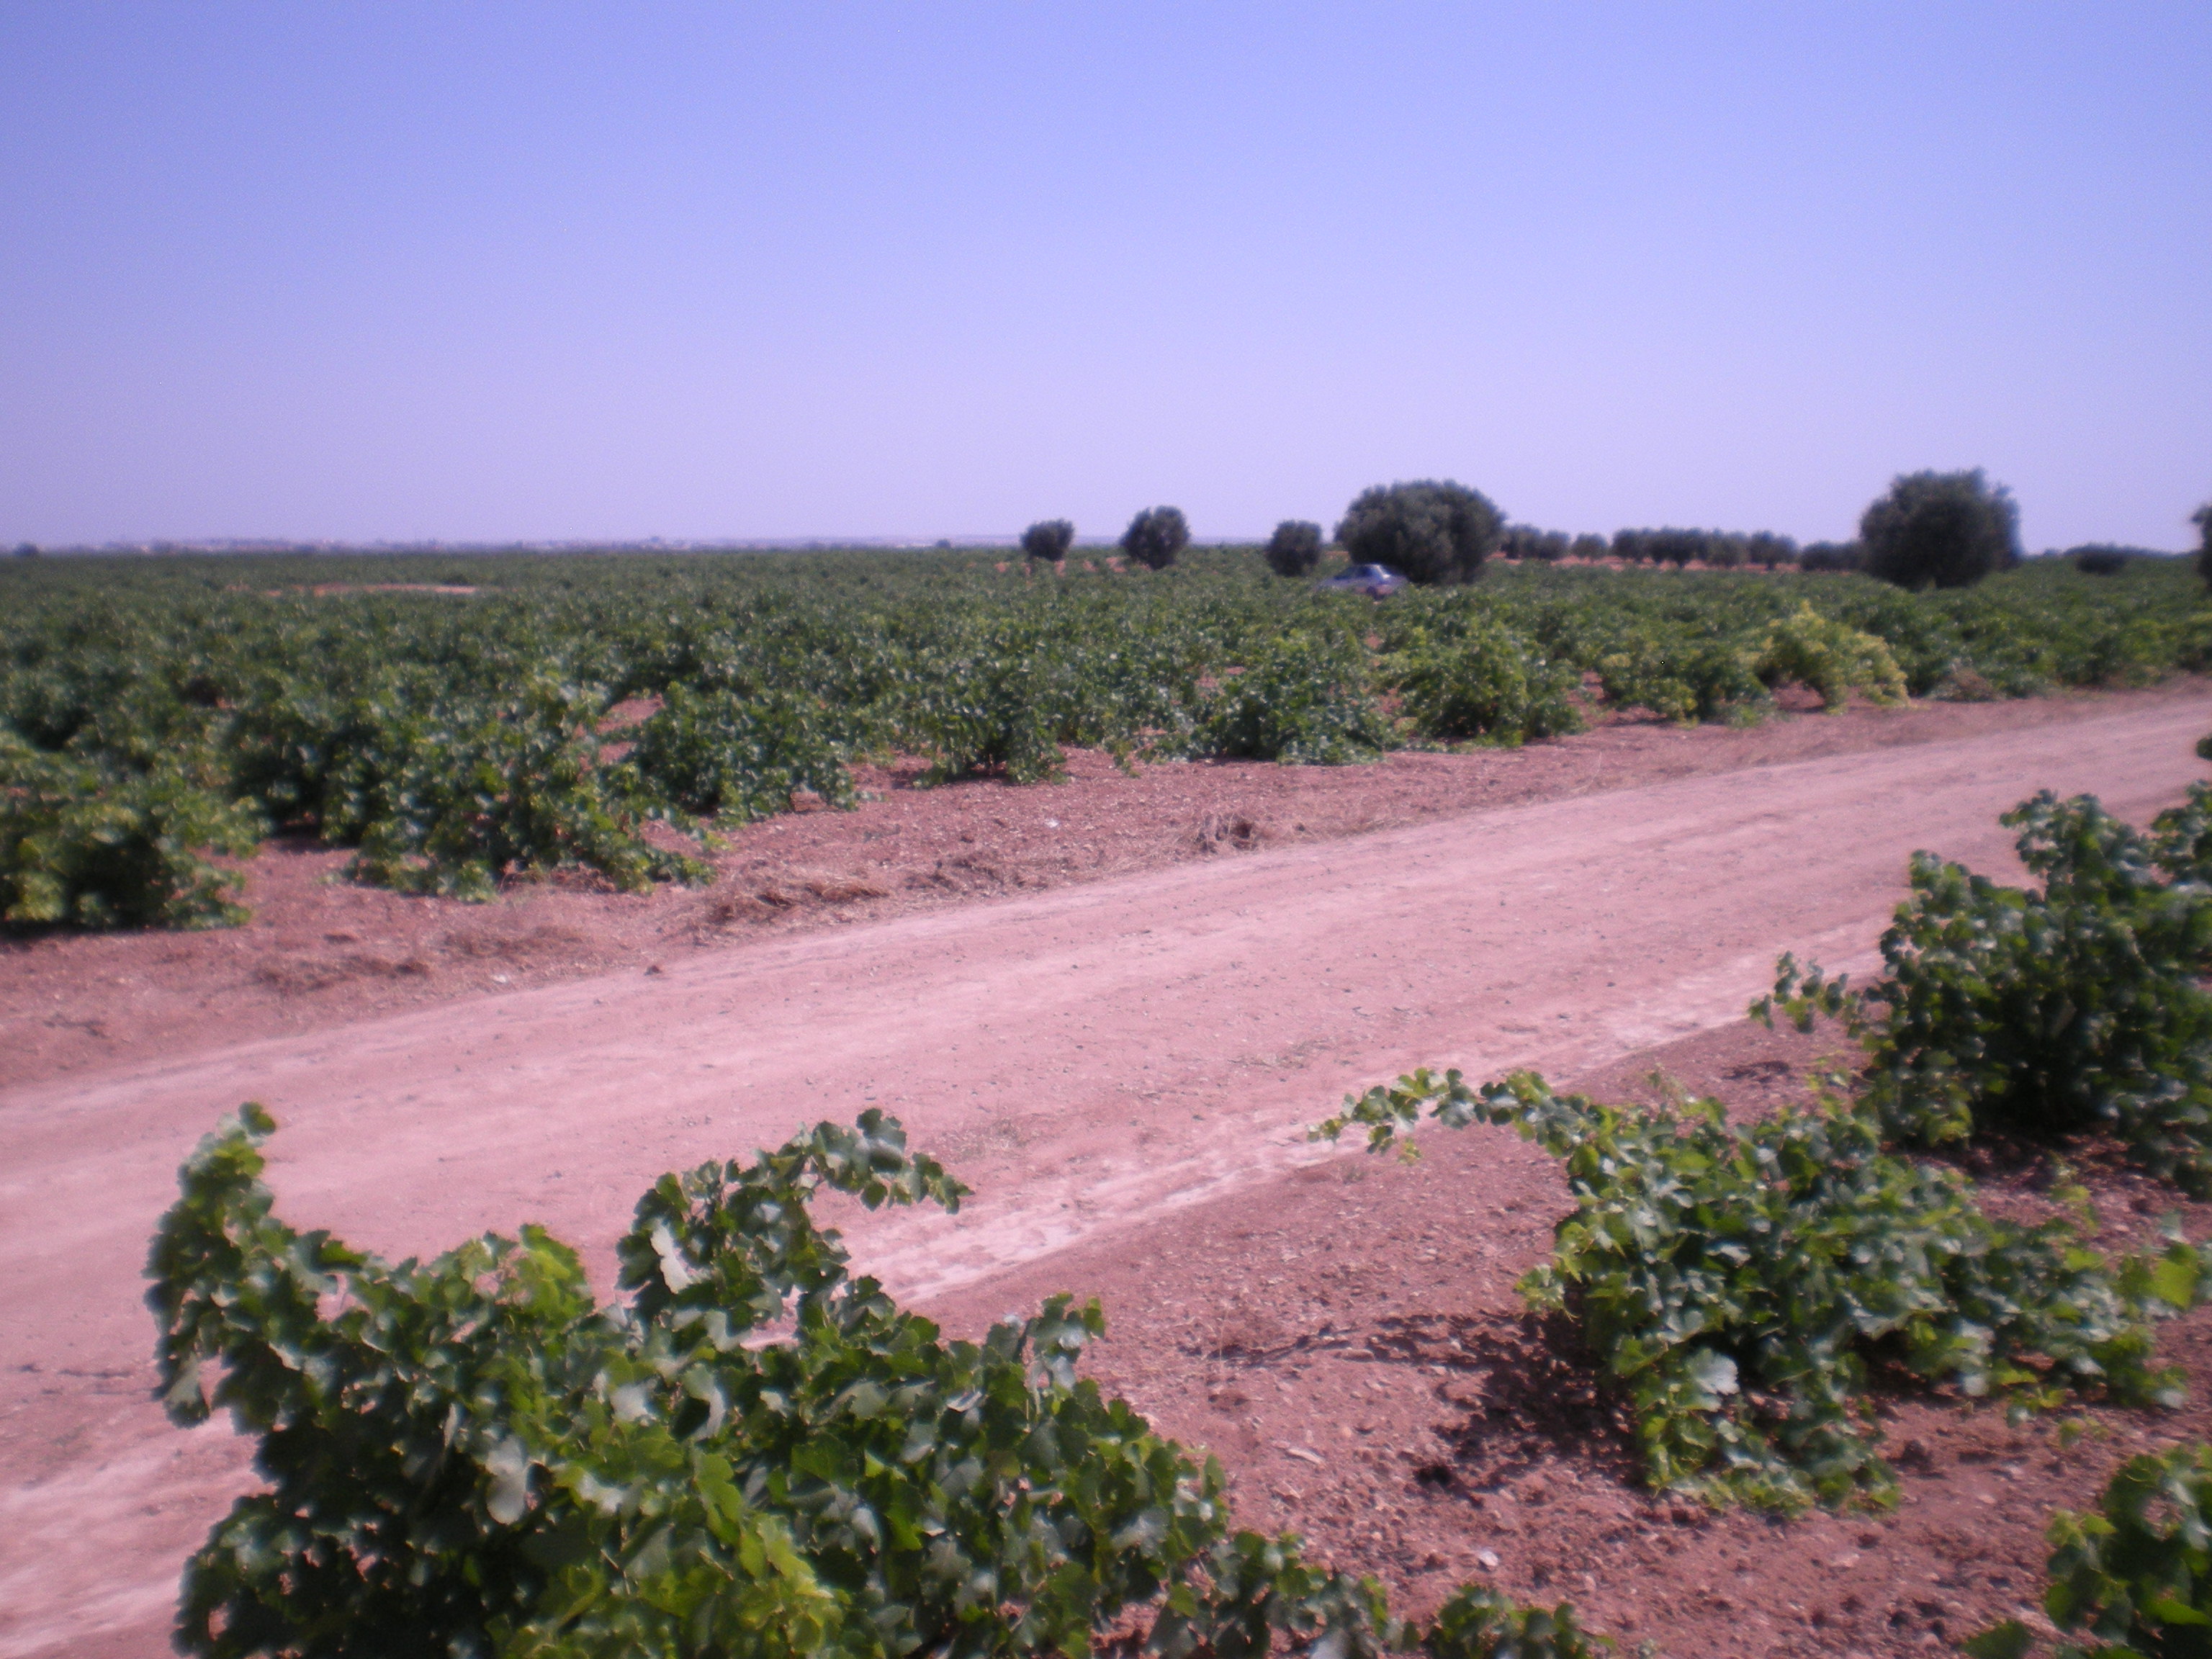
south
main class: Cropland
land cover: Vineyards
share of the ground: 25 - 50 %
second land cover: Other bare soil
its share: > 75 %
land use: Agriculture (excluding fallow land and kitchen gardens)
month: July
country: ES
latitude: 39.5691
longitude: -3.0912
